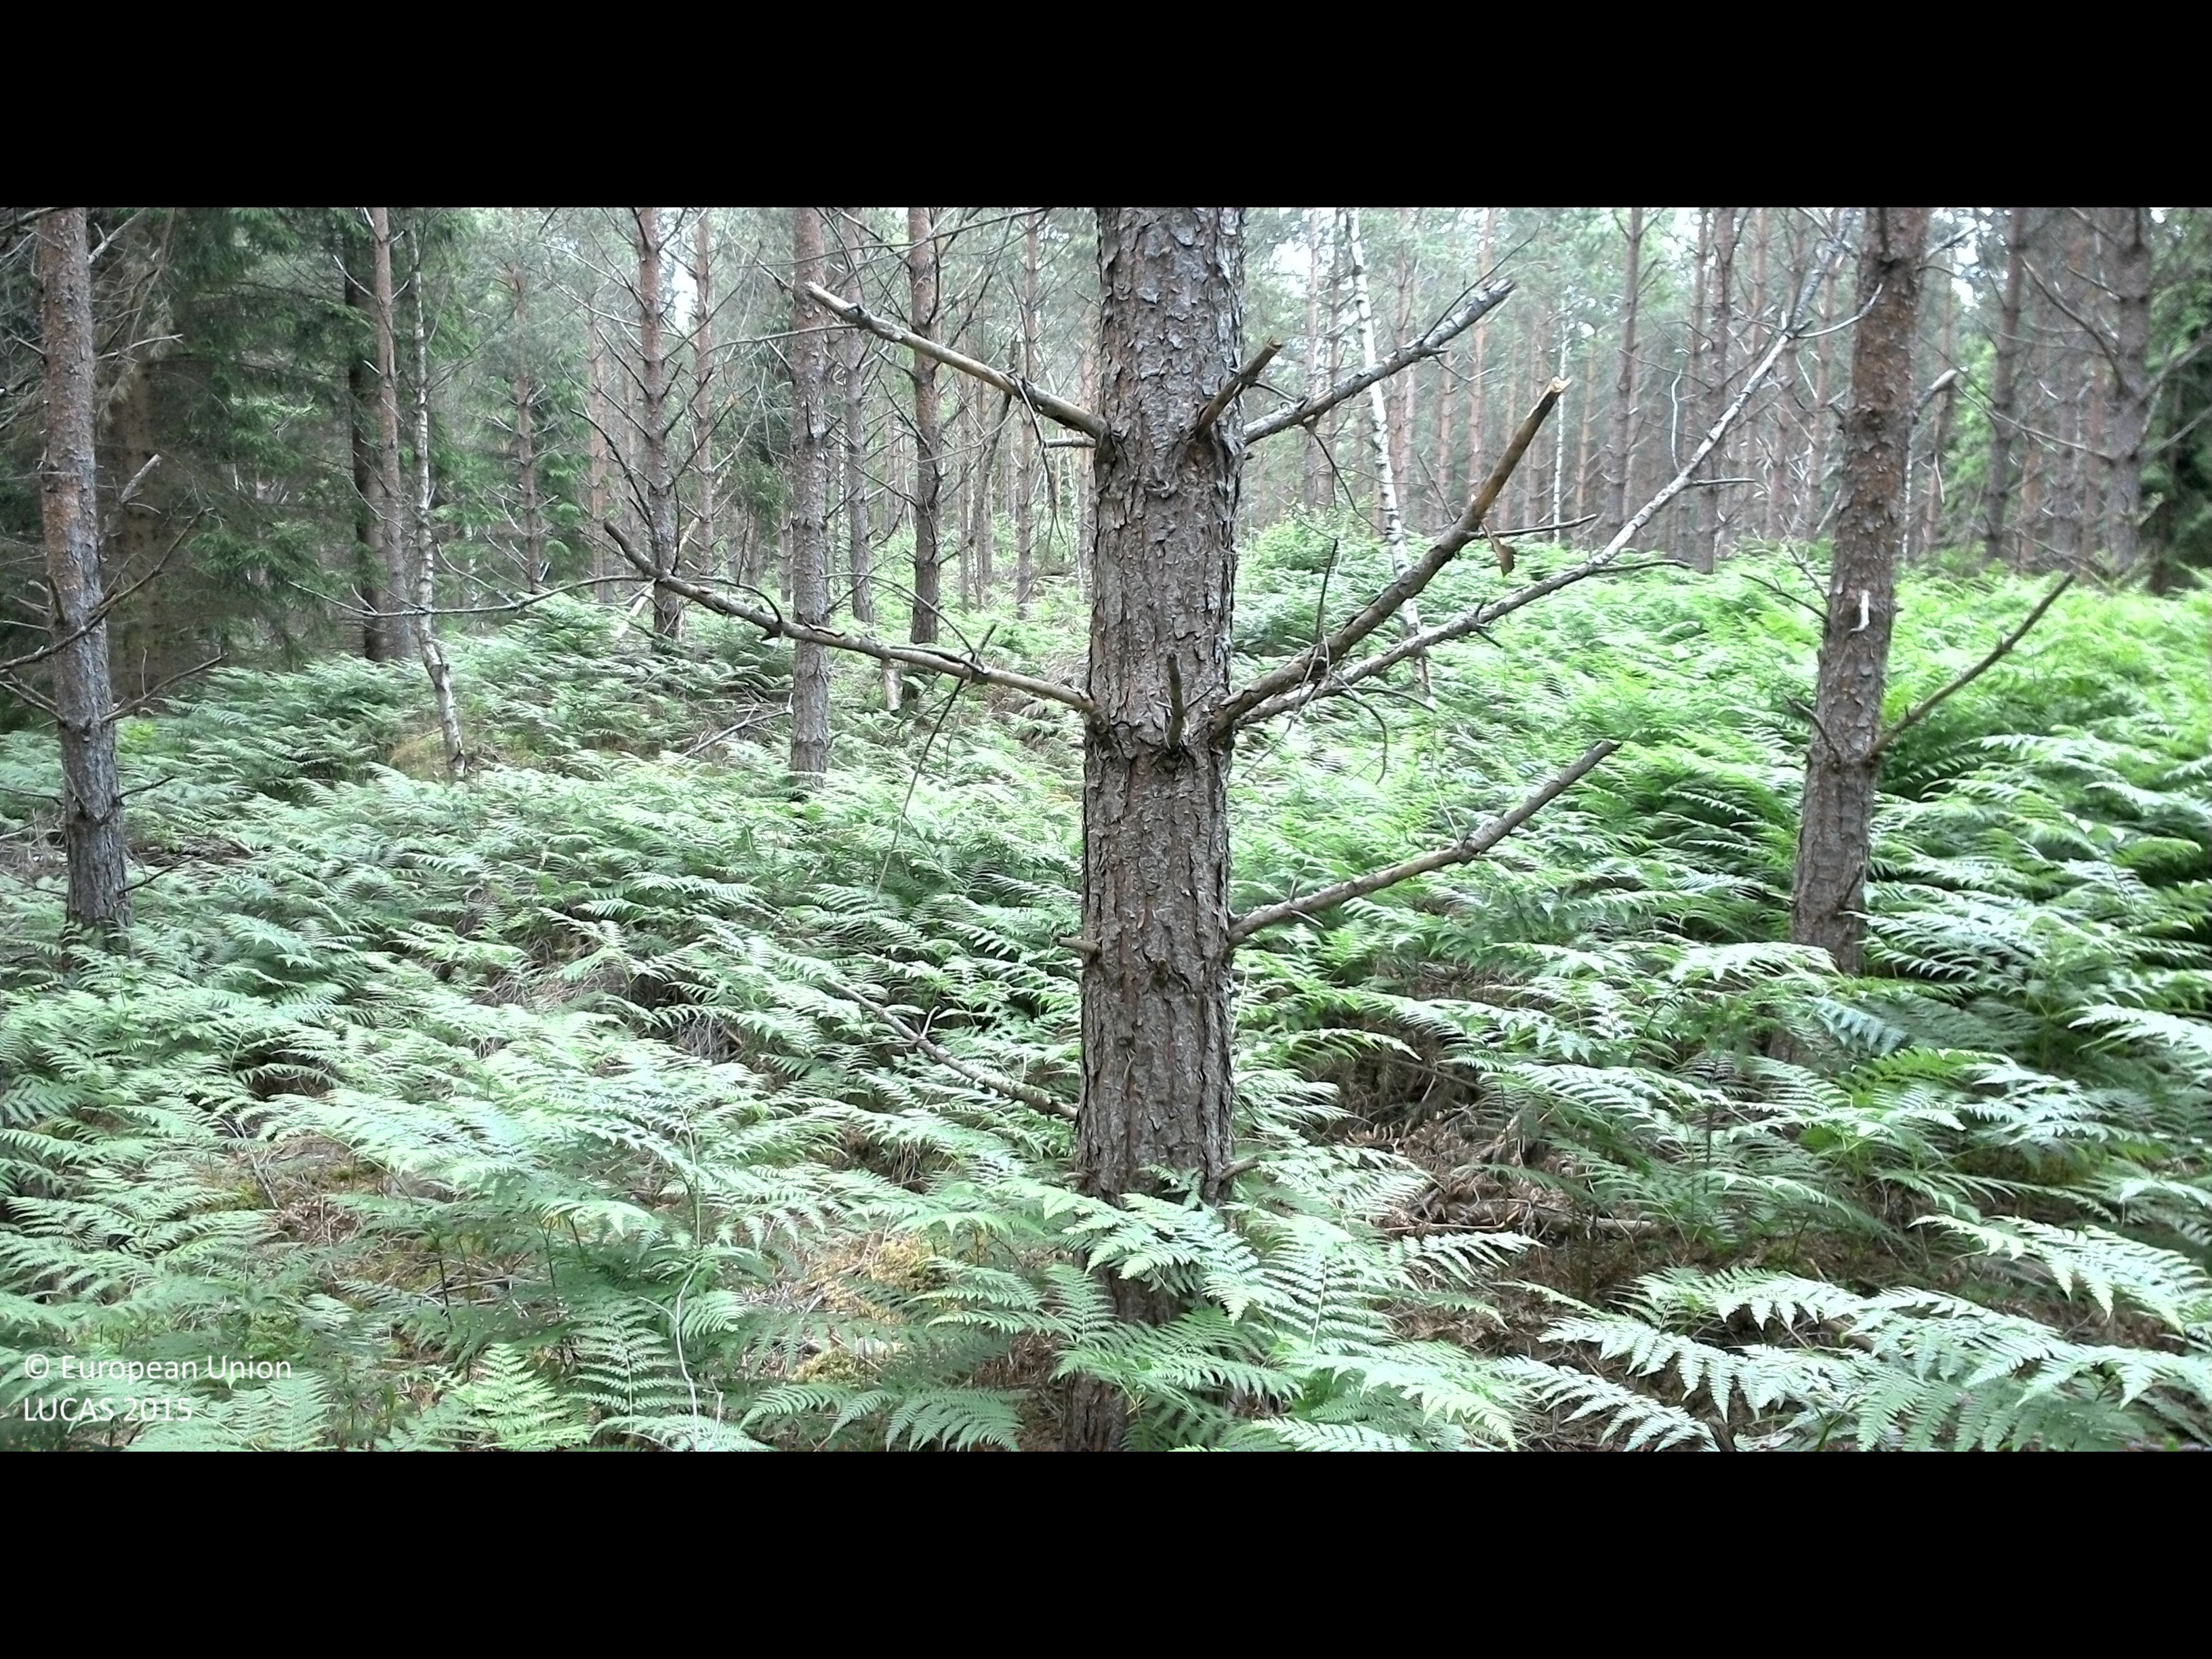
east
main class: Woodland
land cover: Pine dominated coniferous woodland
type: boreal forest
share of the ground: 50 - 75 %
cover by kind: coniferous forest trees 50 %, herbaceous plants 40 %, broadleaved forest trees 5 %, lichens and mosses 5 %
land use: Forestry
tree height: > 5 m
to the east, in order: Pine dominated coniferous woodland; Tracks; Pine dominated coniferous woodland; Paved roads, cycling and walking lanes; Grass margins; Pine dominated coniferous woodland
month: June
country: SE
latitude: 56.4940
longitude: 16.0915
